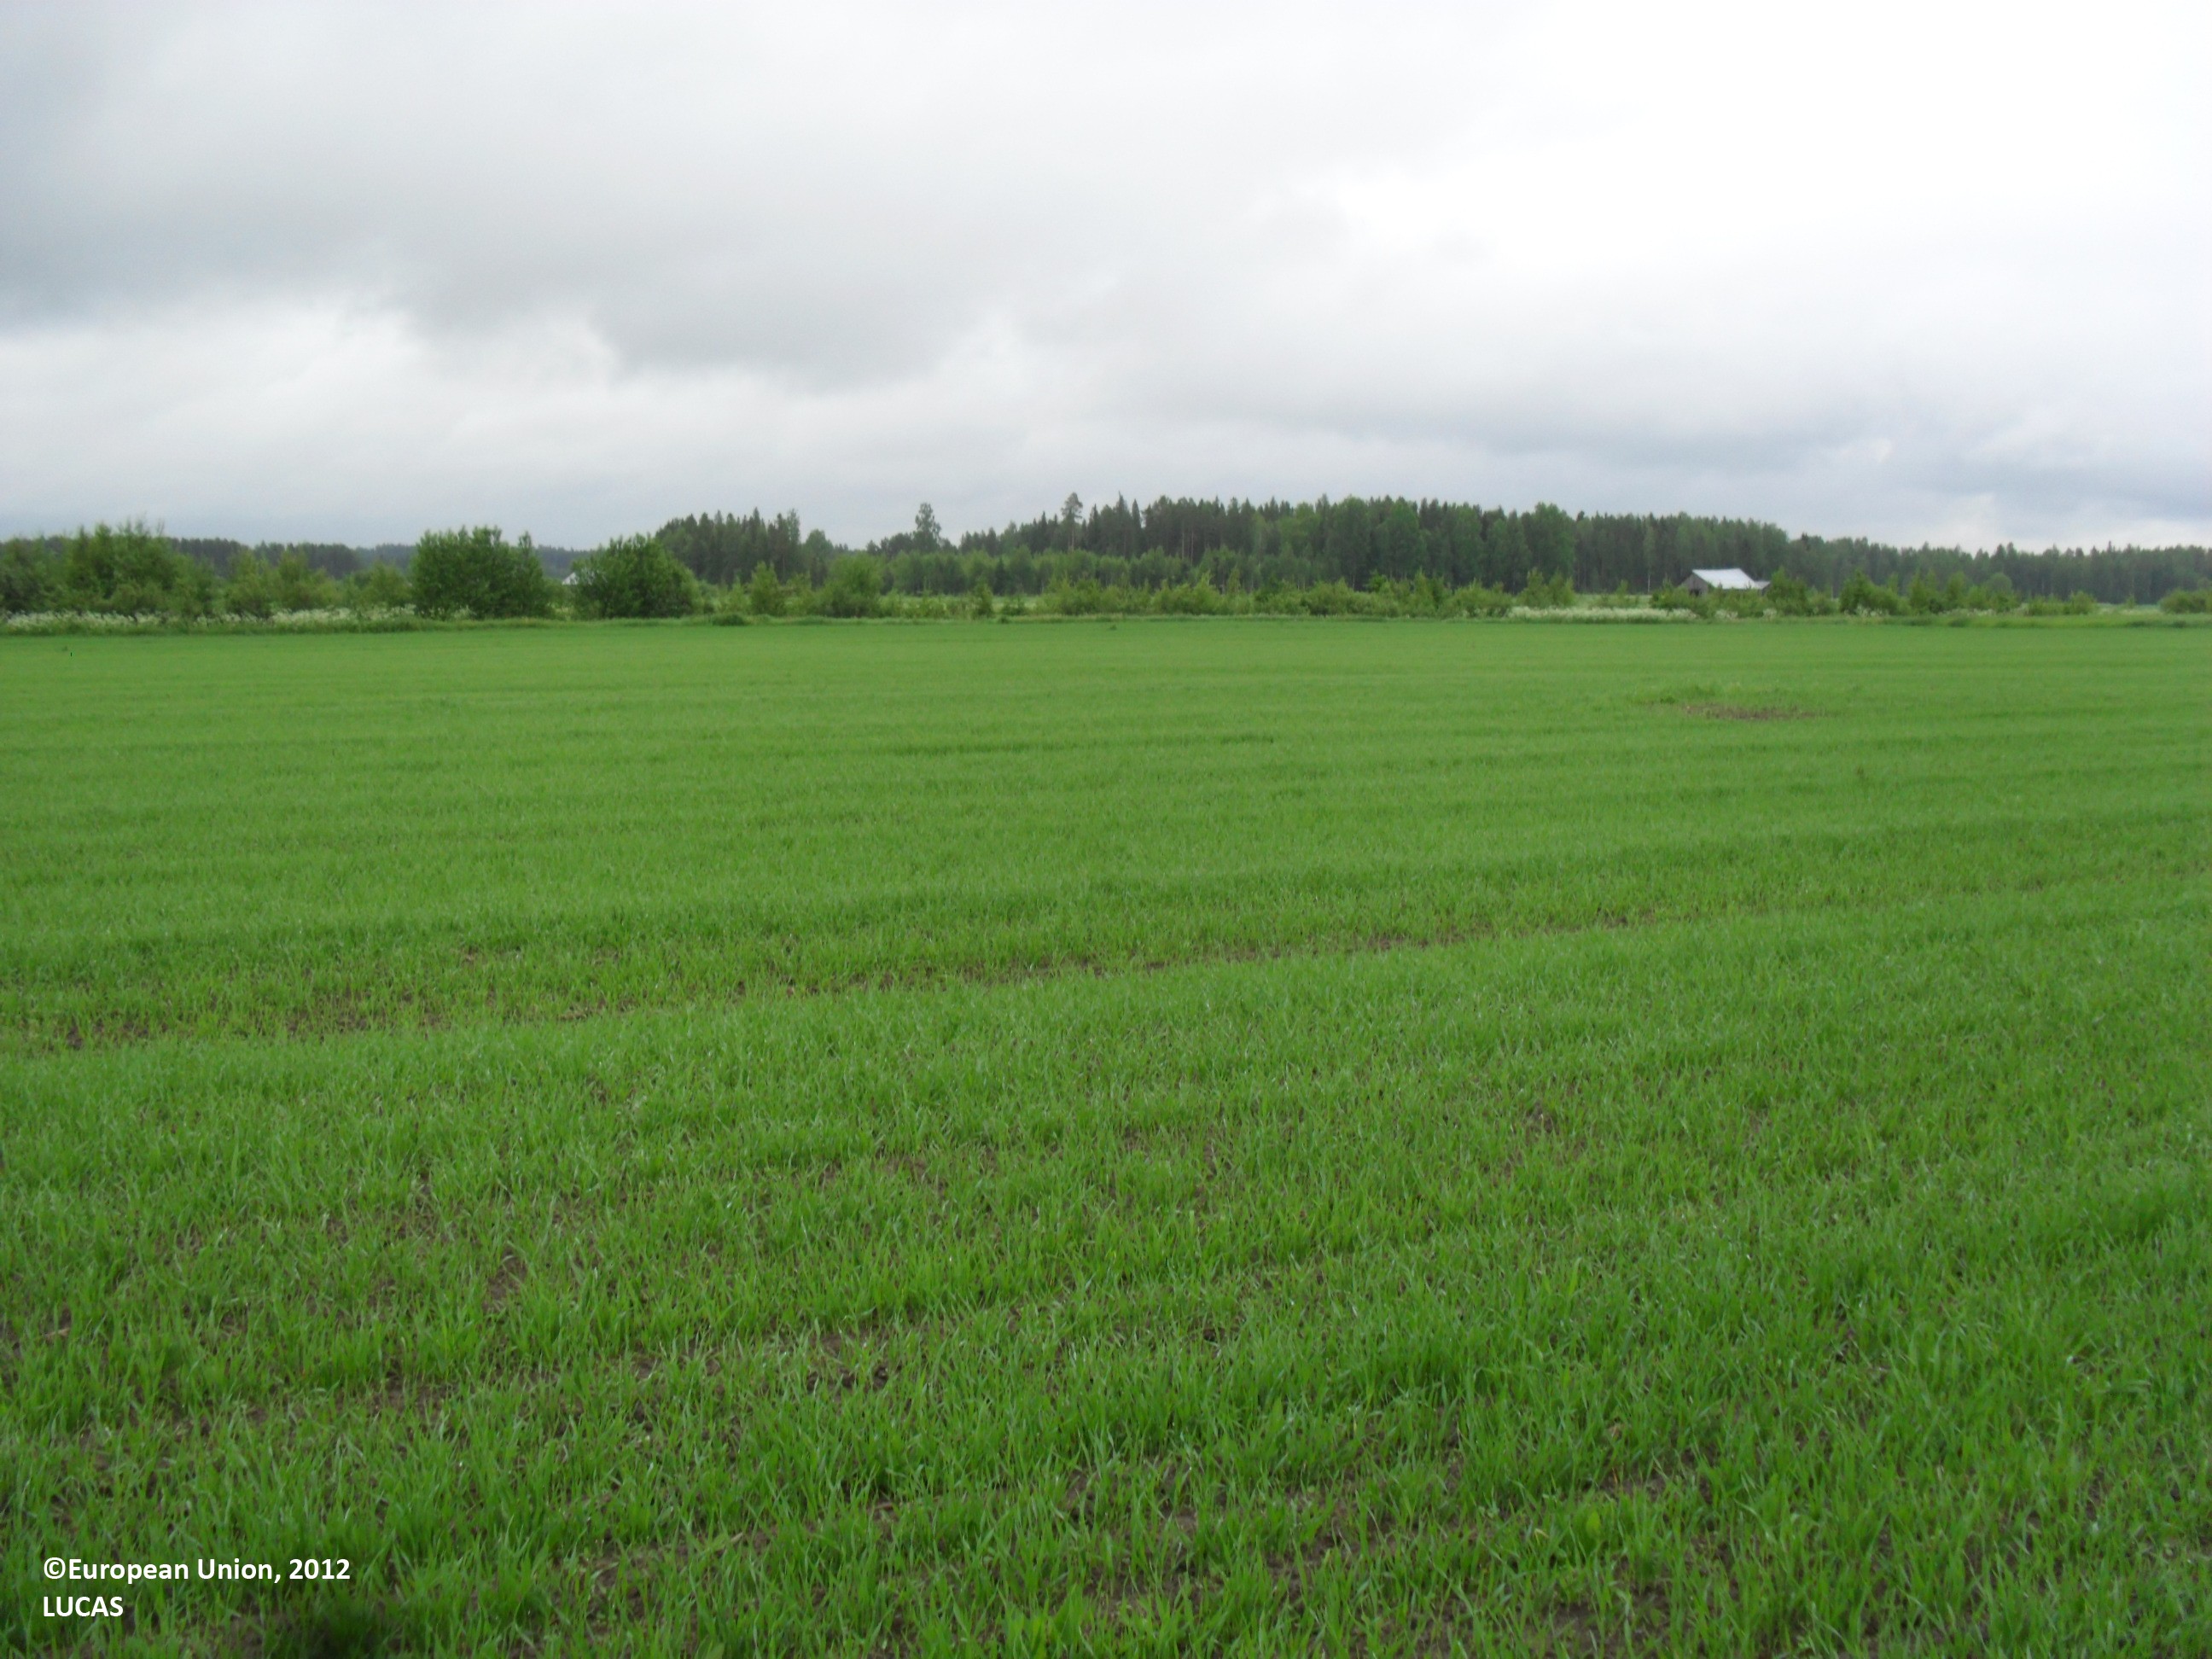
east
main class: Cropland
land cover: Barley
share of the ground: 50 - 75 %
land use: Agriculture (excluding fallow land and kitchen gardens)
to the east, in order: Barley; Grassland without tree/shrub cover; Rivers and streams; Abandoned hedges; Oats; Grass margins; Tracks; Grass margins; Ditches and canals; Oats
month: June
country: FI
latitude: 63.0745
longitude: 23.1843
